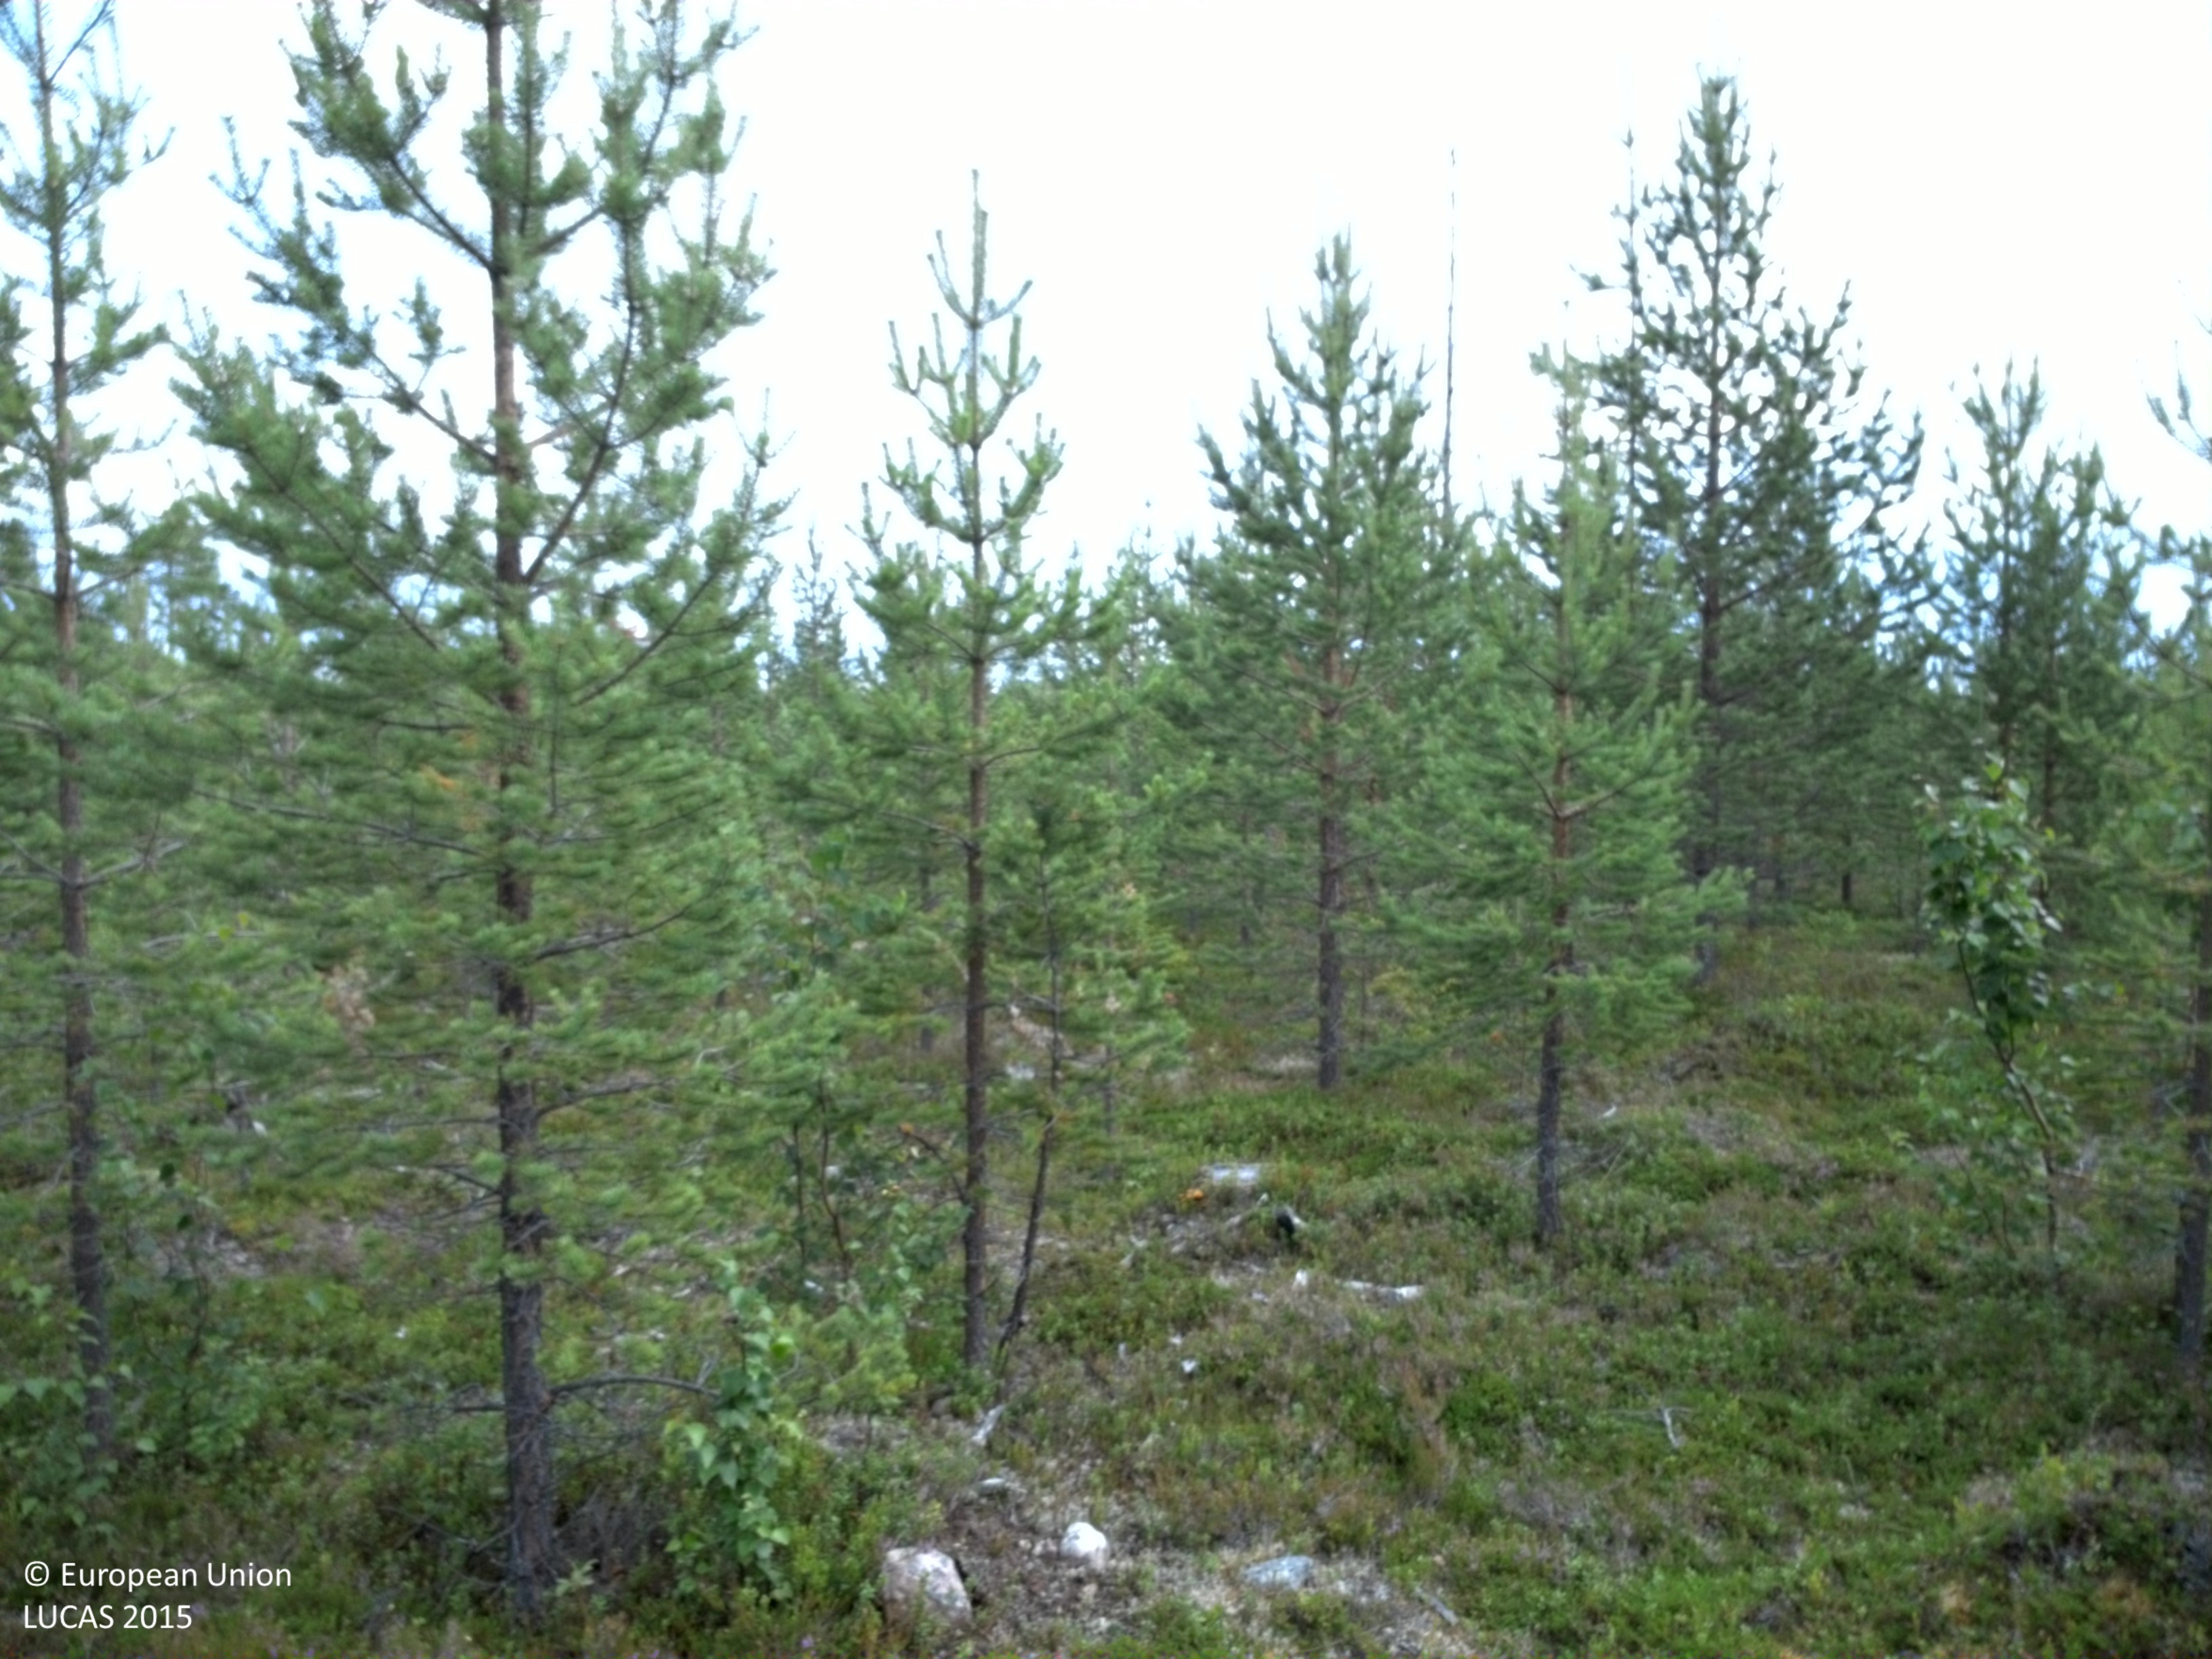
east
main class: Woodland
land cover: Pine dominated coniferous woodland
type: boreal forest
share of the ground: 25 - 50 %
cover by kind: shrubs 55 %, coniferous forest trees 30 %, lichens and mosses 15 %
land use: Forestry
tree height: > 5 m
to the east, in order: Pine dominated coniferous woodland; Shrubland with sparse tree cover; Pine dominated coniferous woodland; Artificial constructions; Ditches and canals; Pine dominated coniferous woodland; Broadleaved woodland; Shrubland with sparse tree cover; Paved roads, cycling and walking lanes; Groves; Pine dominated coniferous woodland
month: August
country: SE
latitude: 66.3343
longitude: 20.4734
